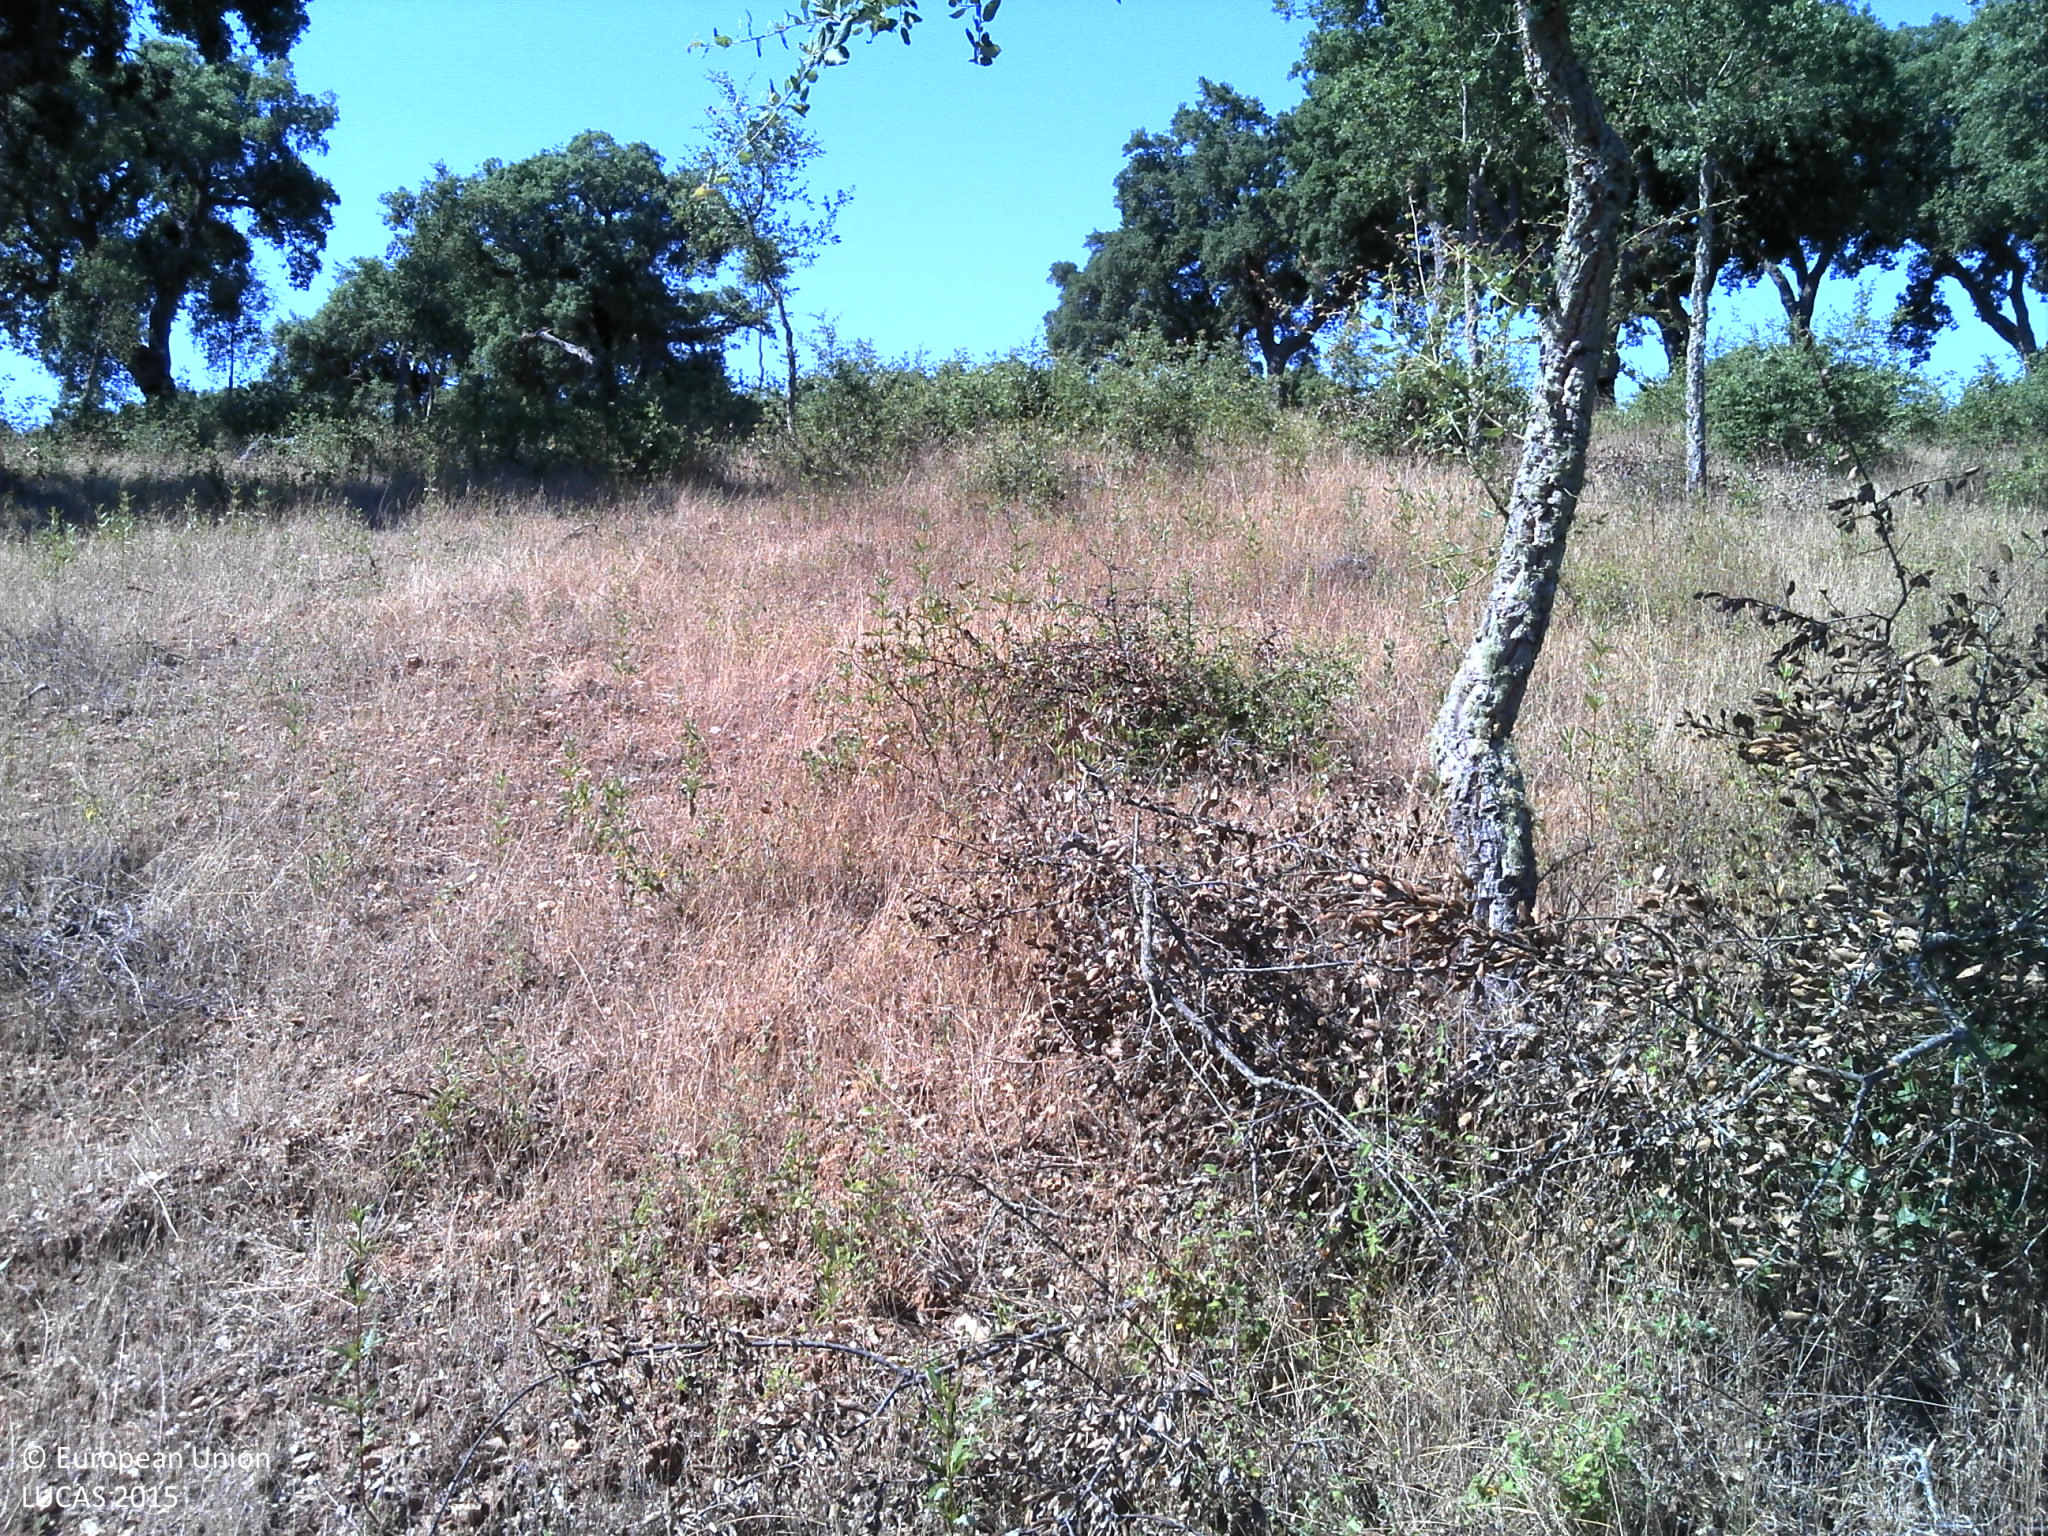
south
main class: Woodland
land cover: Broadleaved woodland
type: broadleaved evergreen forest
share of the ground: 25 - 50 %
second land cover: Grassland without tree/shrub cover
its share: 25 - 50 %
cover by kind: broadleaved forest trees 40 %, herbaceous plants 40 %, consolidated bare surface 20 %
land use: Forestry
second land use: Agriculture (excluding fallow land and kitchen gardens)
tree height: > 5 m
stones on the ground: < 10 %
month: June
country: PT
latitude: 37.8019
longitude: -8.5179
